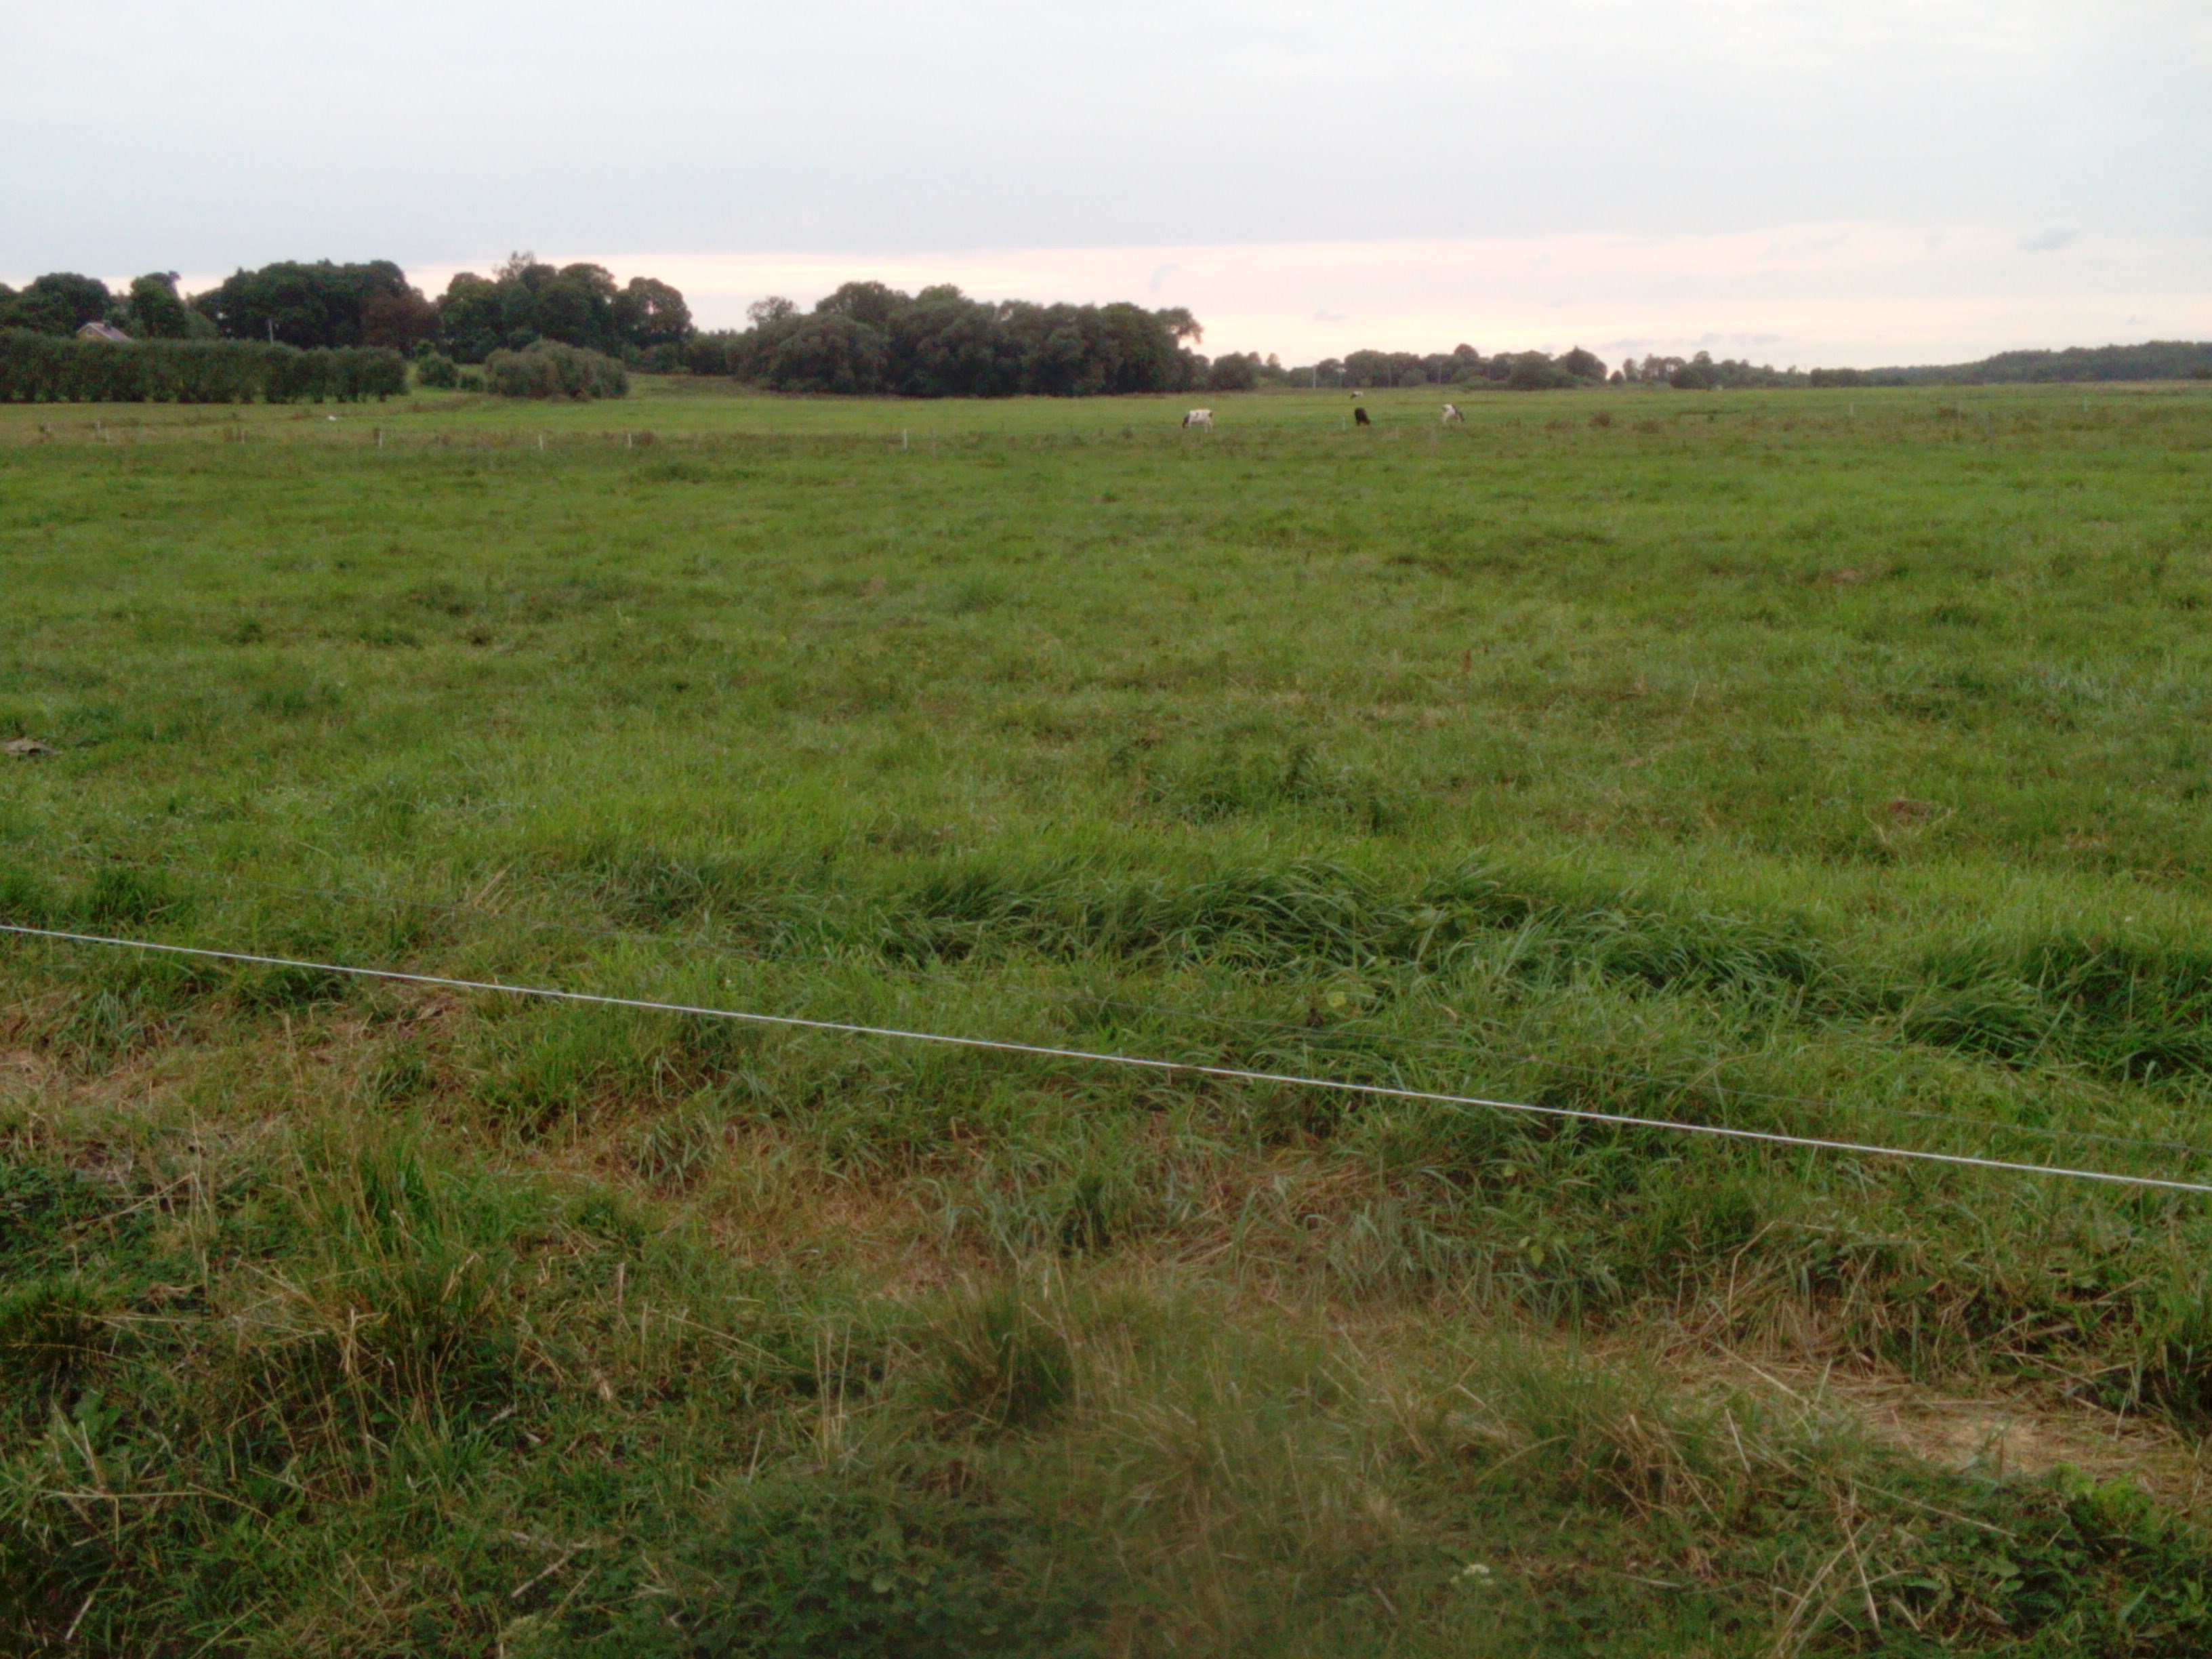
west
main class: Grassland
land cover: Grassland without tree/shrub cover
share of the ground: > 75 %
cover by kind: herbaceous plants 100 %
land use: Agriculture (excluding fallow land and kitchen gardens)
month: September
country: LT
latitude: 55.7767
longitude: 22.8360
